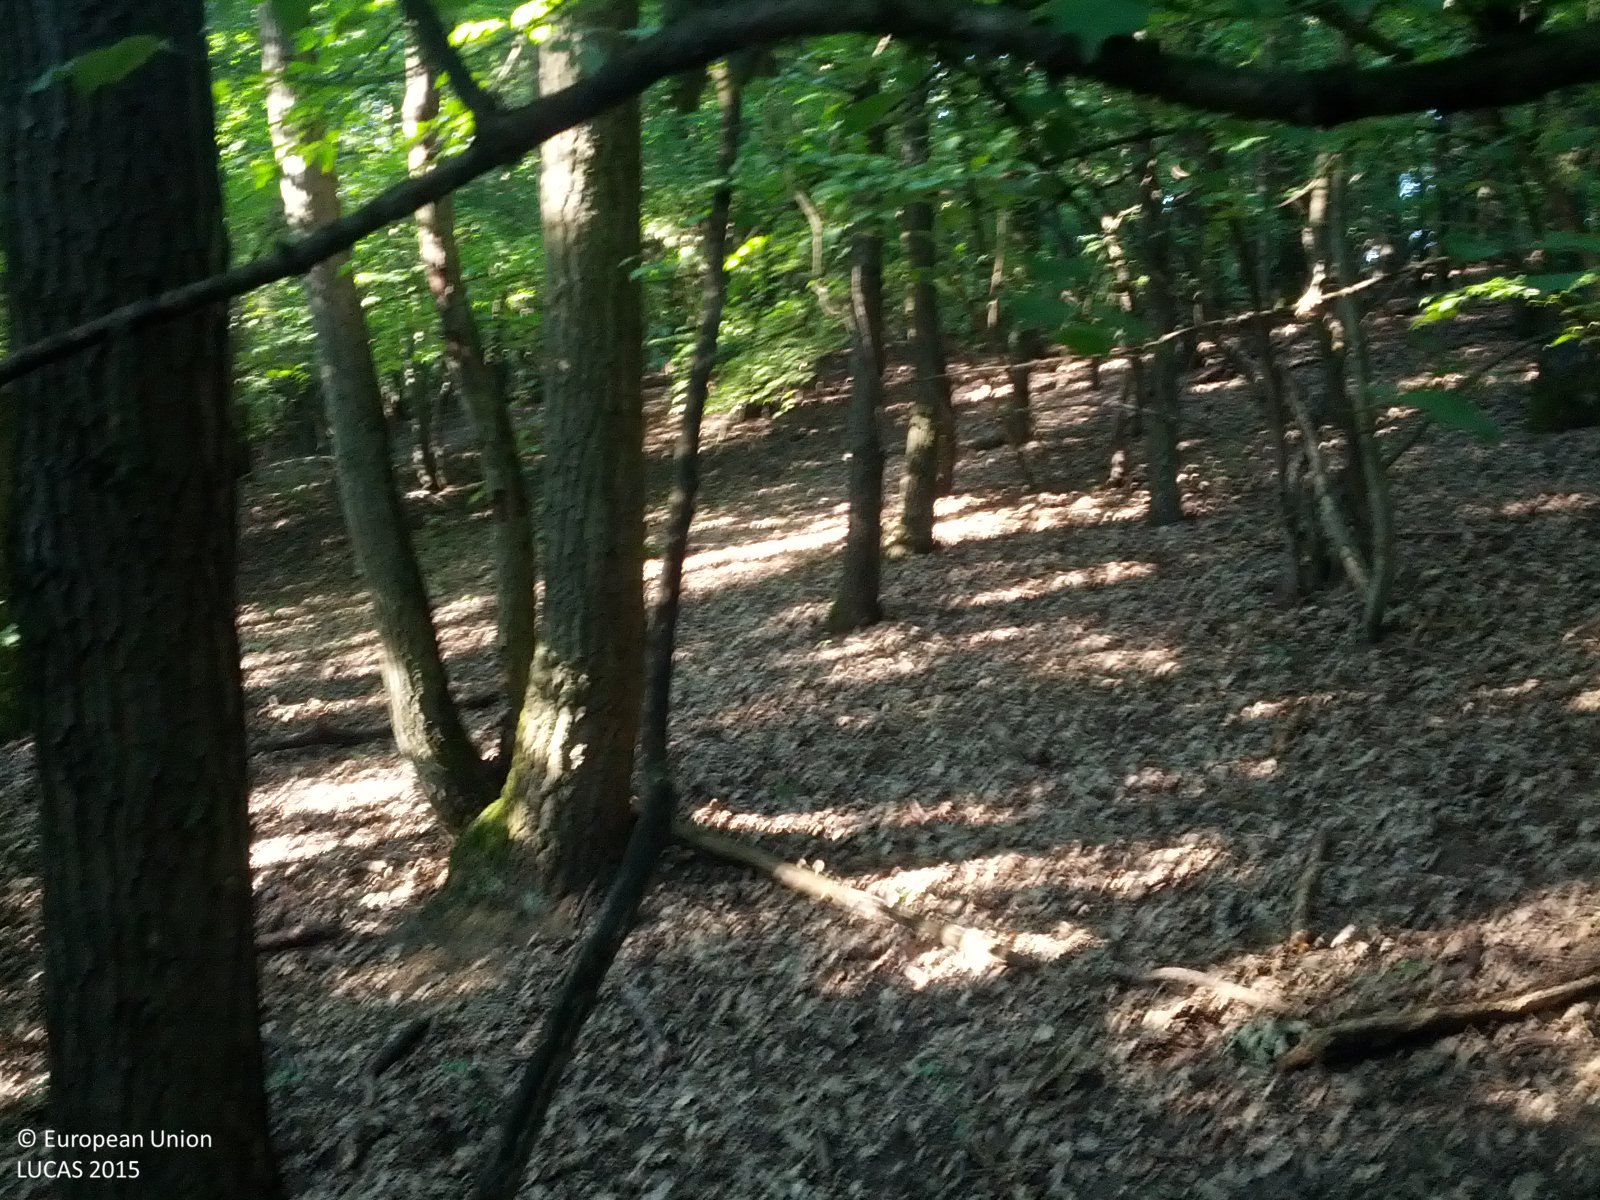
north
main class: Woodland
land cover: Broadleaved woodland
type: mesophytic deciduous forest
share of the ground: > 75 %
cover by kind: broadleaved forest trees 90 %, unconsolidated bare surface 10 %
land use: Forestry
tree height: > 5 m
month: July
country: AT
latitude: 48.3894
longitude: 16.5557
